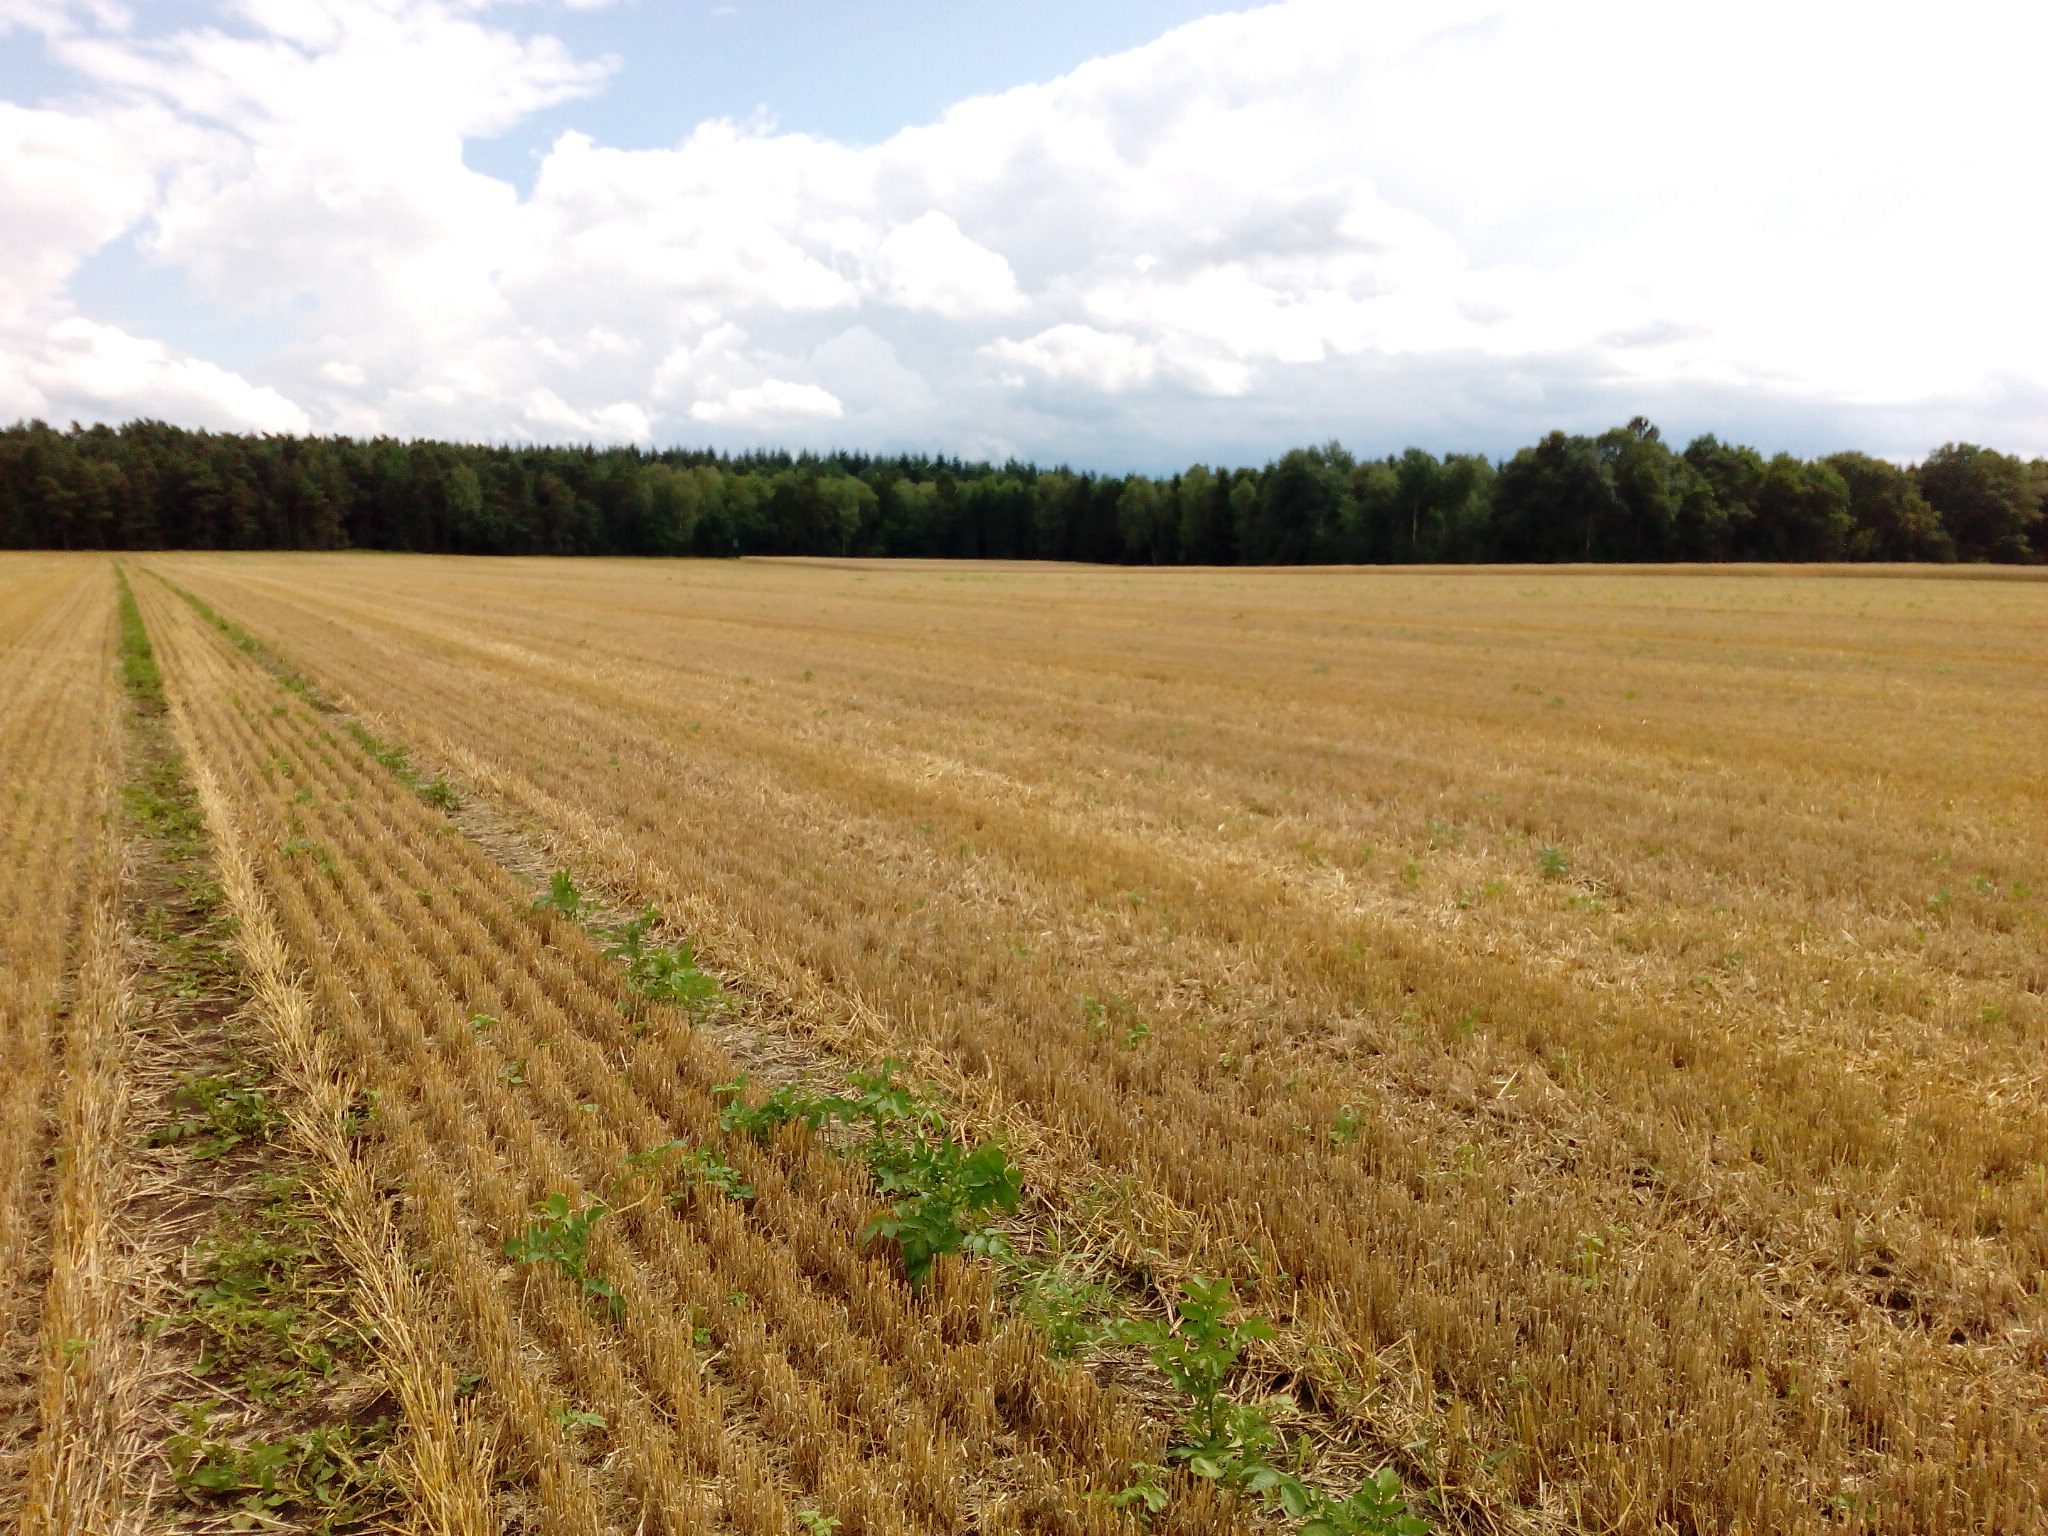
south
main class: Cropland
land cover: Rye
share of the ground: > 75 %
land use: Agriculture (excluding fallow land and kitchen gardens)
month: July
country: DE
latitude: 52.9705
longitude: 9.8660
